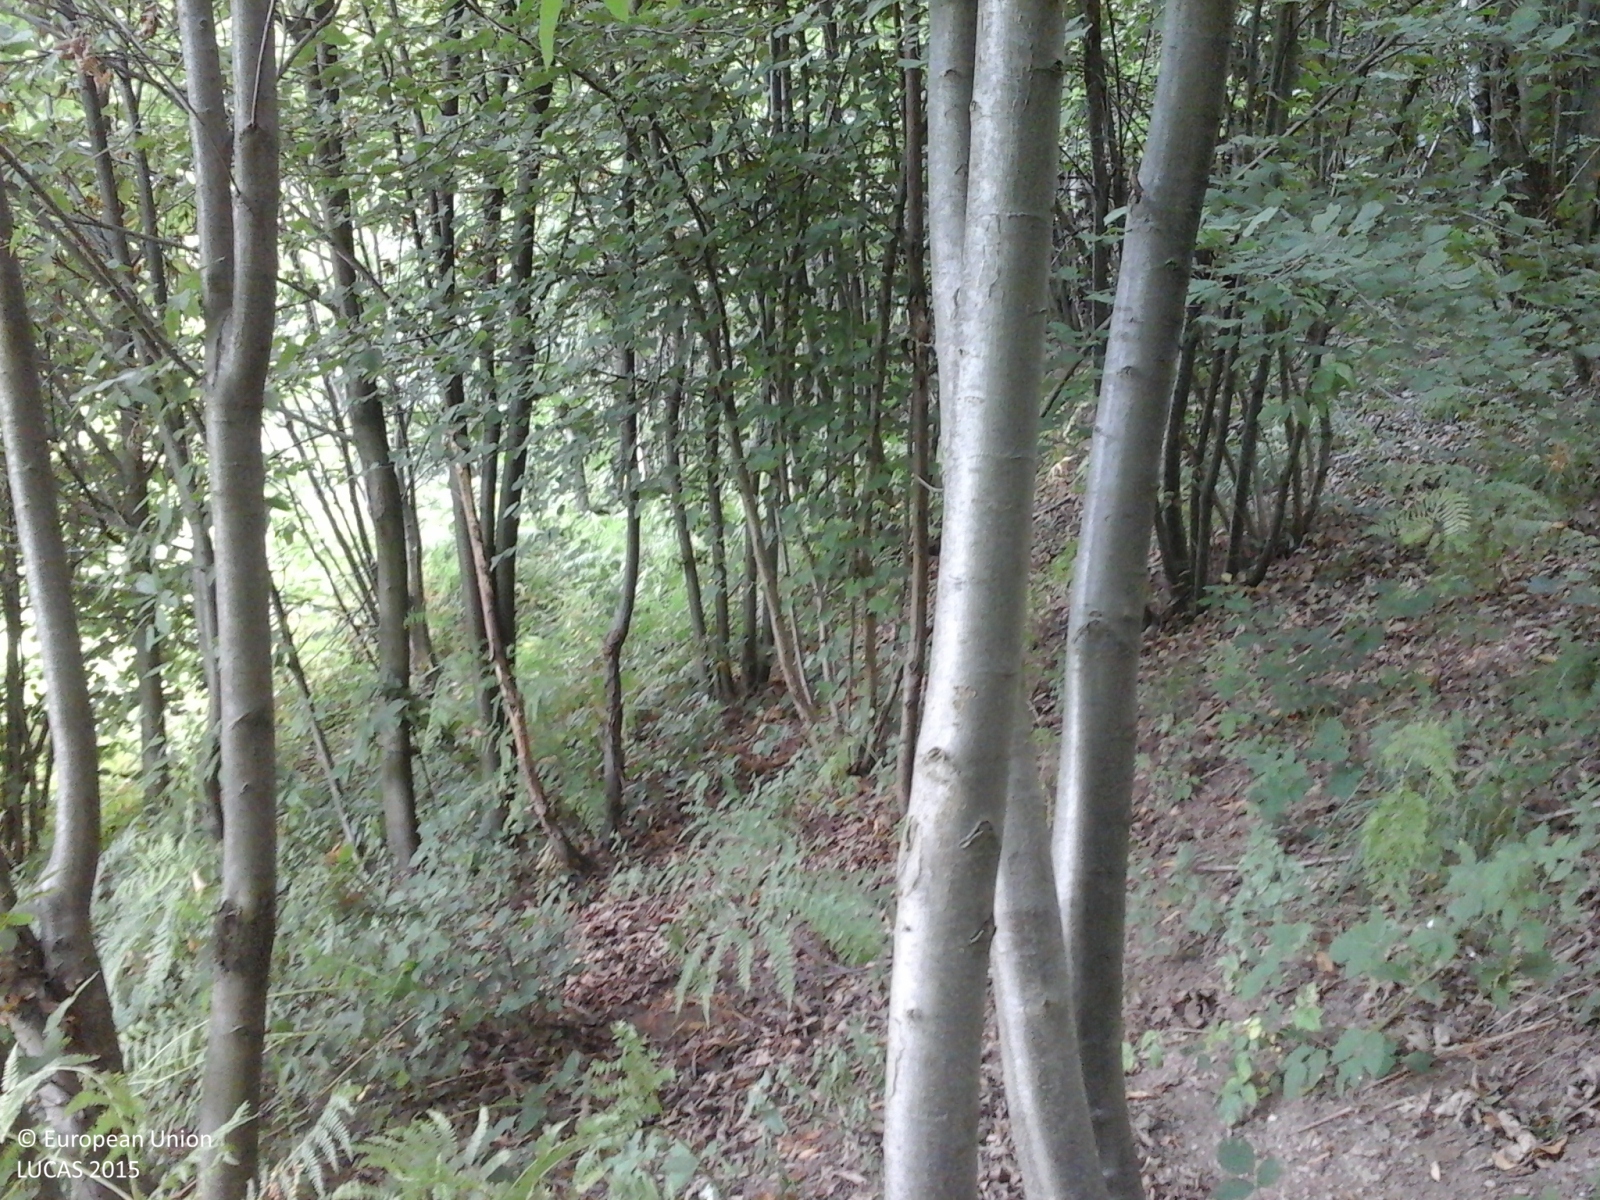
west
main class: Woodland
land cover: Broadleaved woodland
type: thermophilous deciduous forest
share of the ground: > 75 %
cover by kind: broadleaved forest trees 100 %
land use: Semi-natural and natural areas not in use
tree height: > 5 m
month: July
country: IT
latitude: 45.4436
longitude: 7.7151
